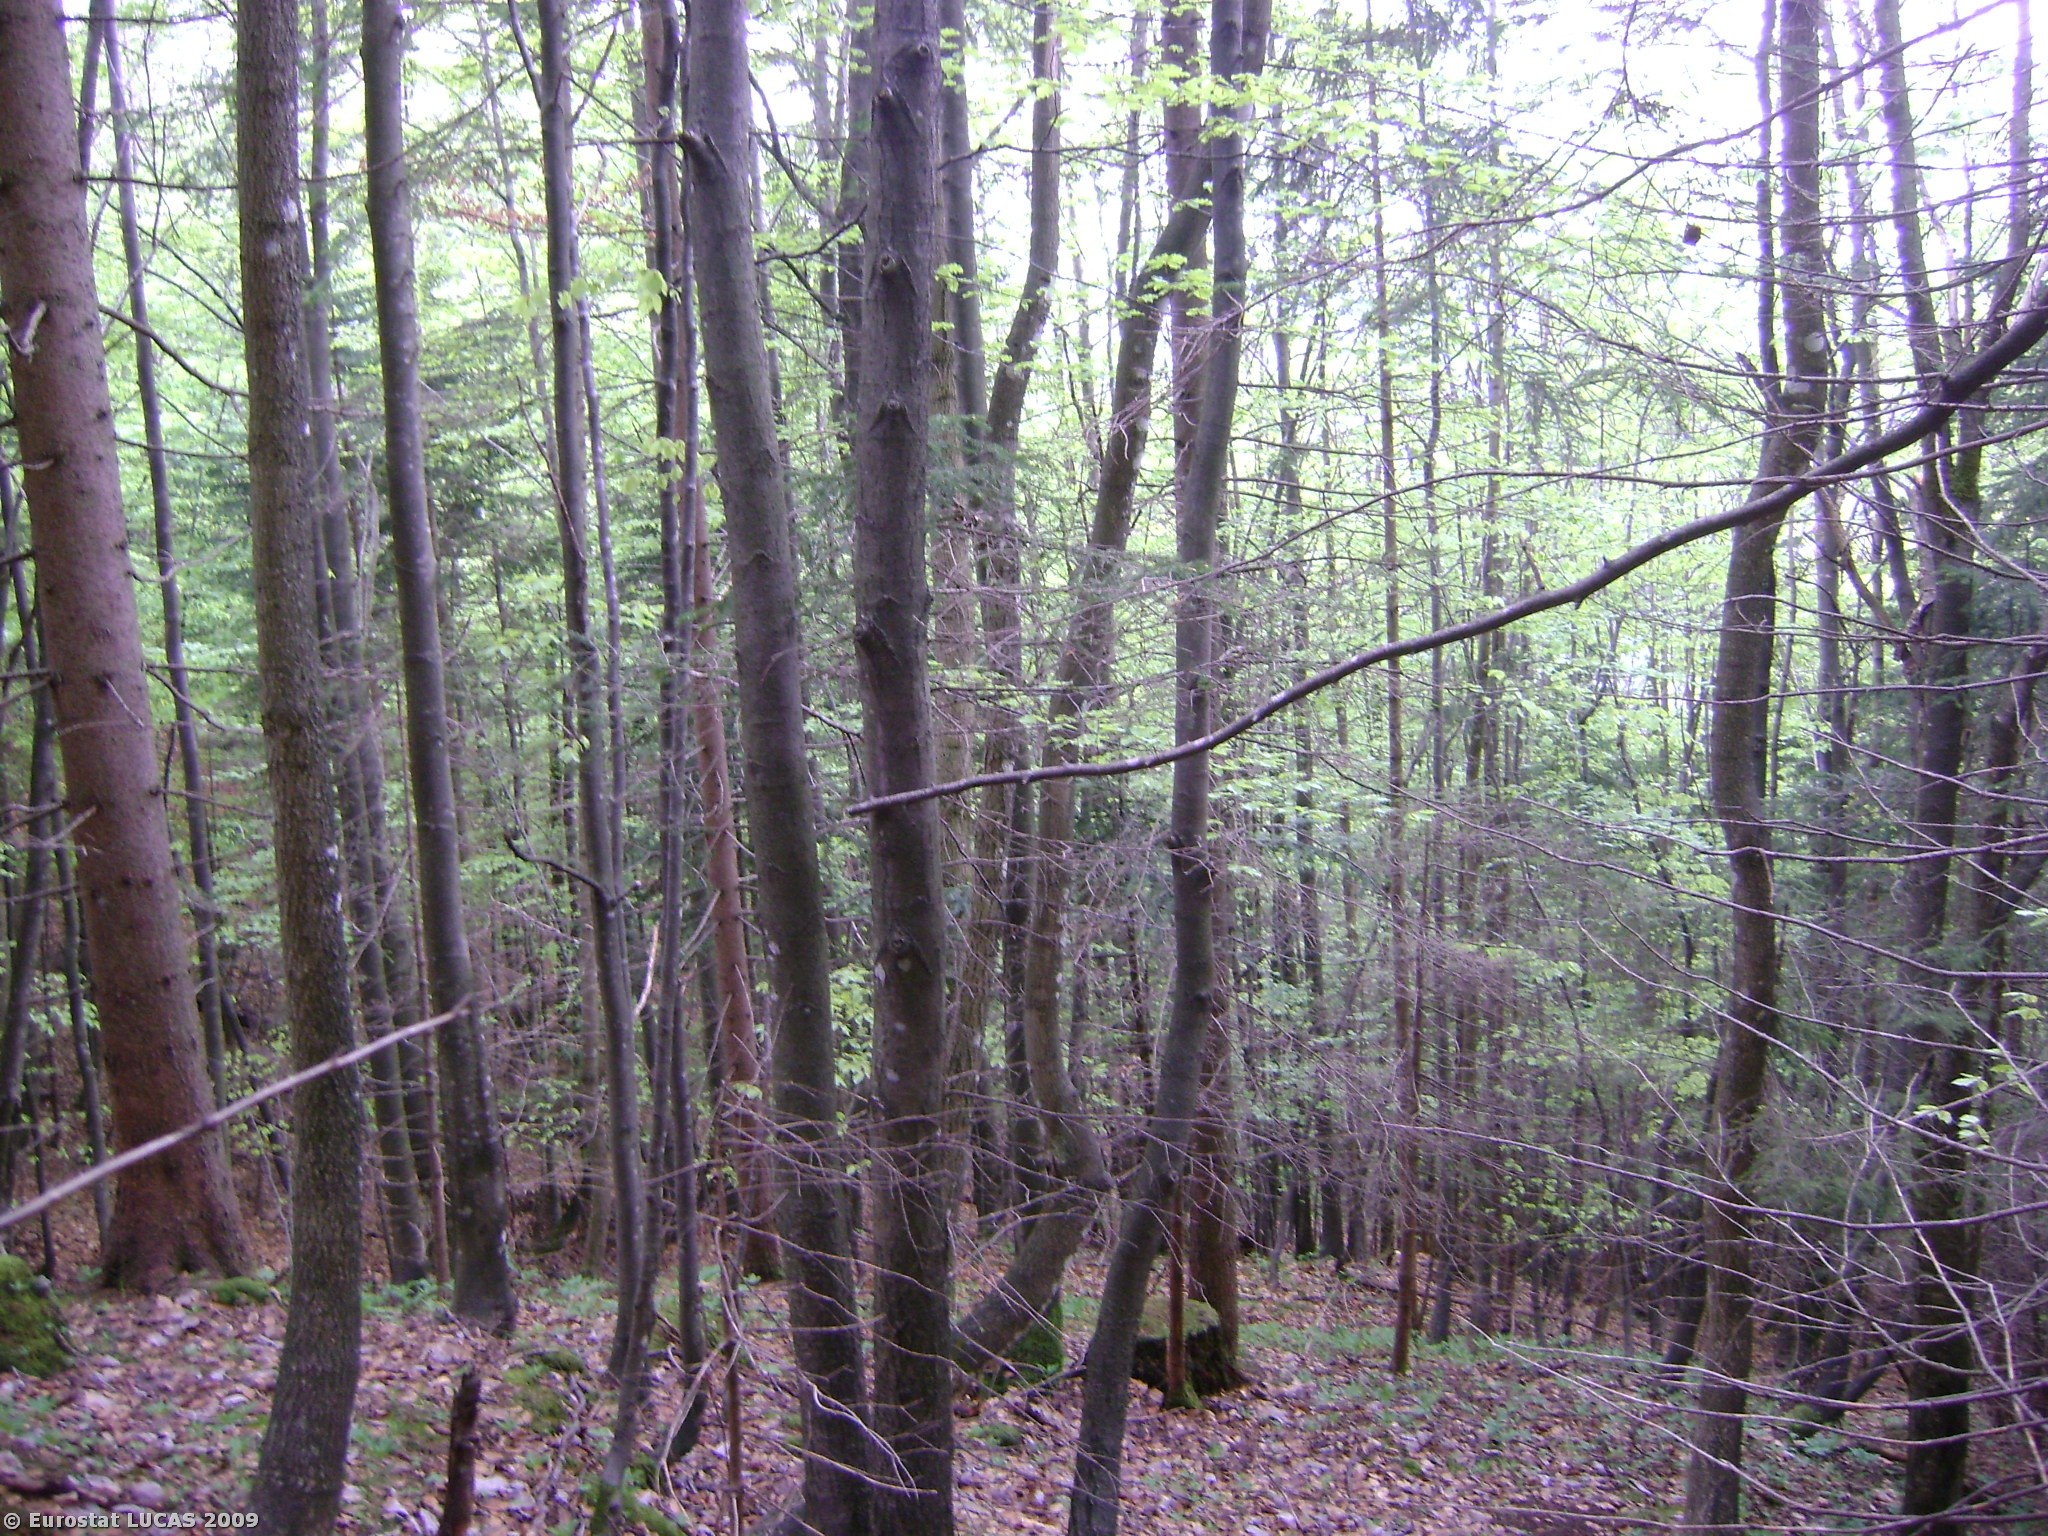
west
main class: Woodland
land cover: Mixed woodland
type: hemiboreal forest and nemoral coniferous forest and mixed broadleaved-coniferous forest
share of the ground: > 75 %
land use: Forestry
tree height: > 5 m
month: May
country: AT
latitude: 47.7984
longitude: 13.2162
